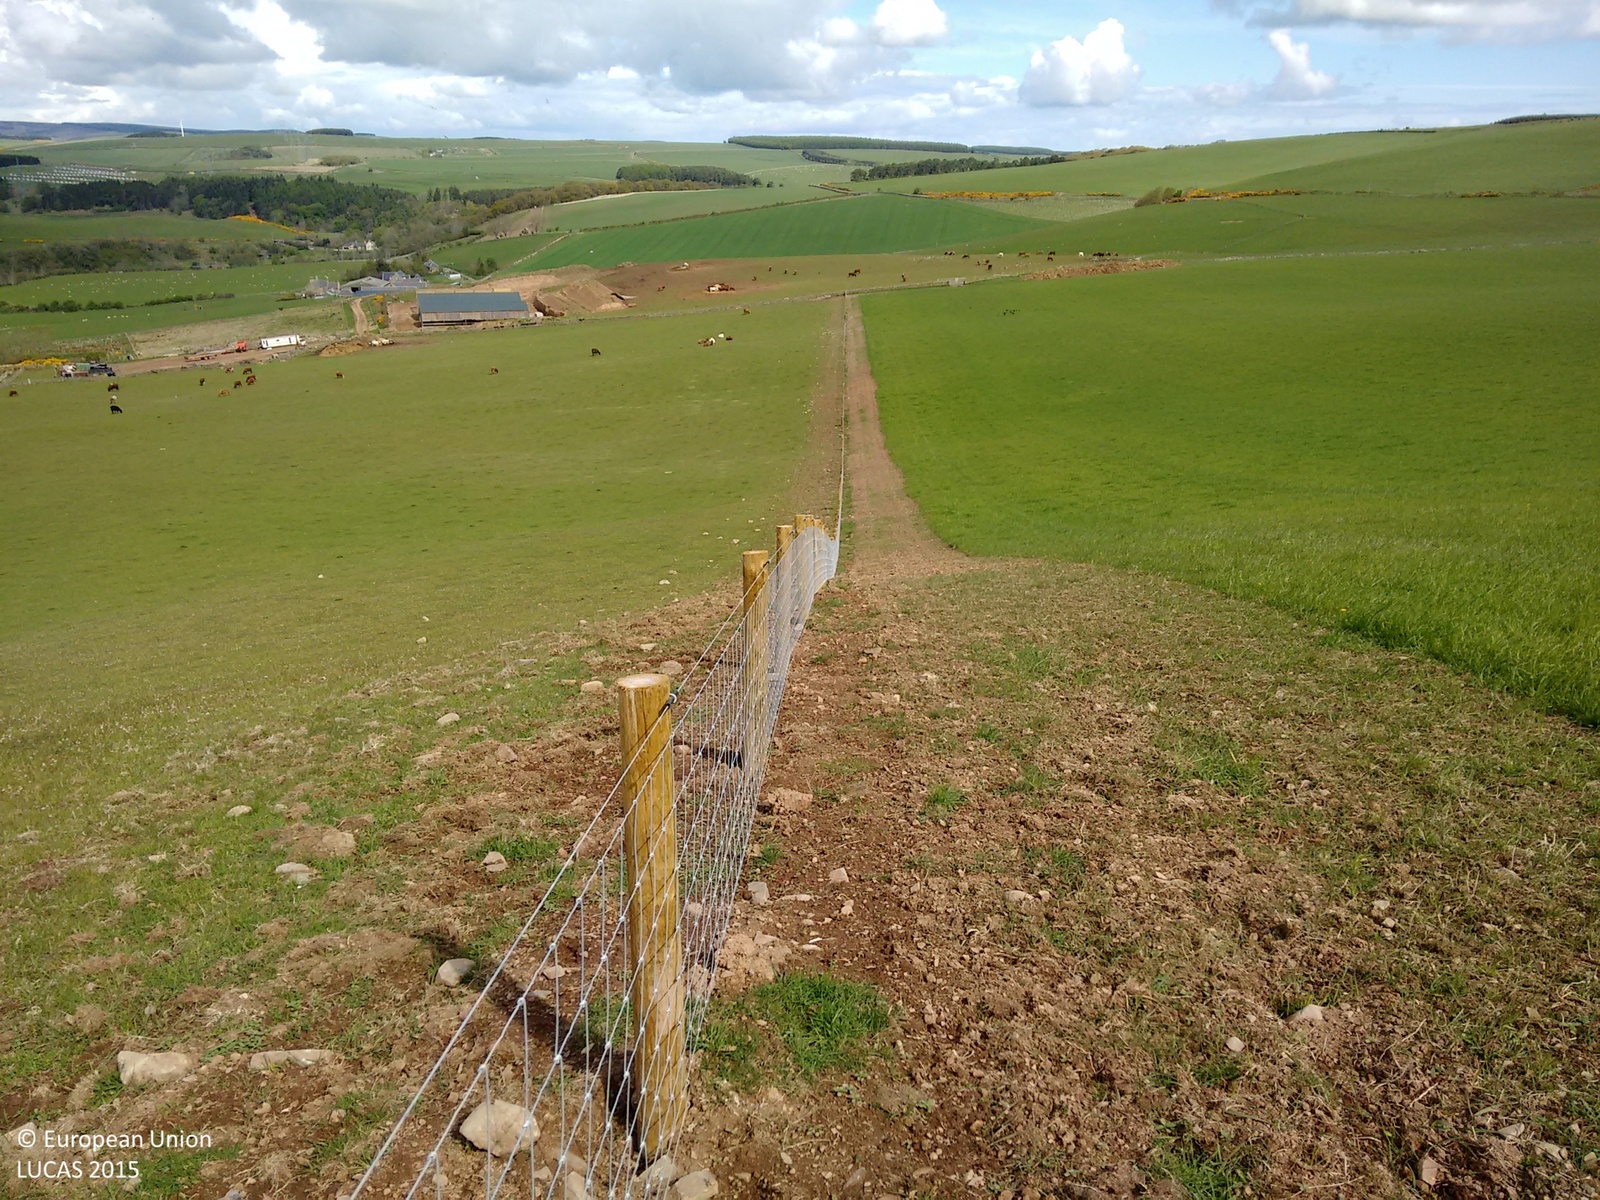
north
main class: Grassland
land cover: Grassland without tree/shrub cover
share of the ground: > 75 %
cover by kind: herbaceous plants 100 %
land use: Agriculture (excluding fallow land and kitchen gardens)
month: May
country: GB
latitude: 55.8268
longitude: -2.3329
